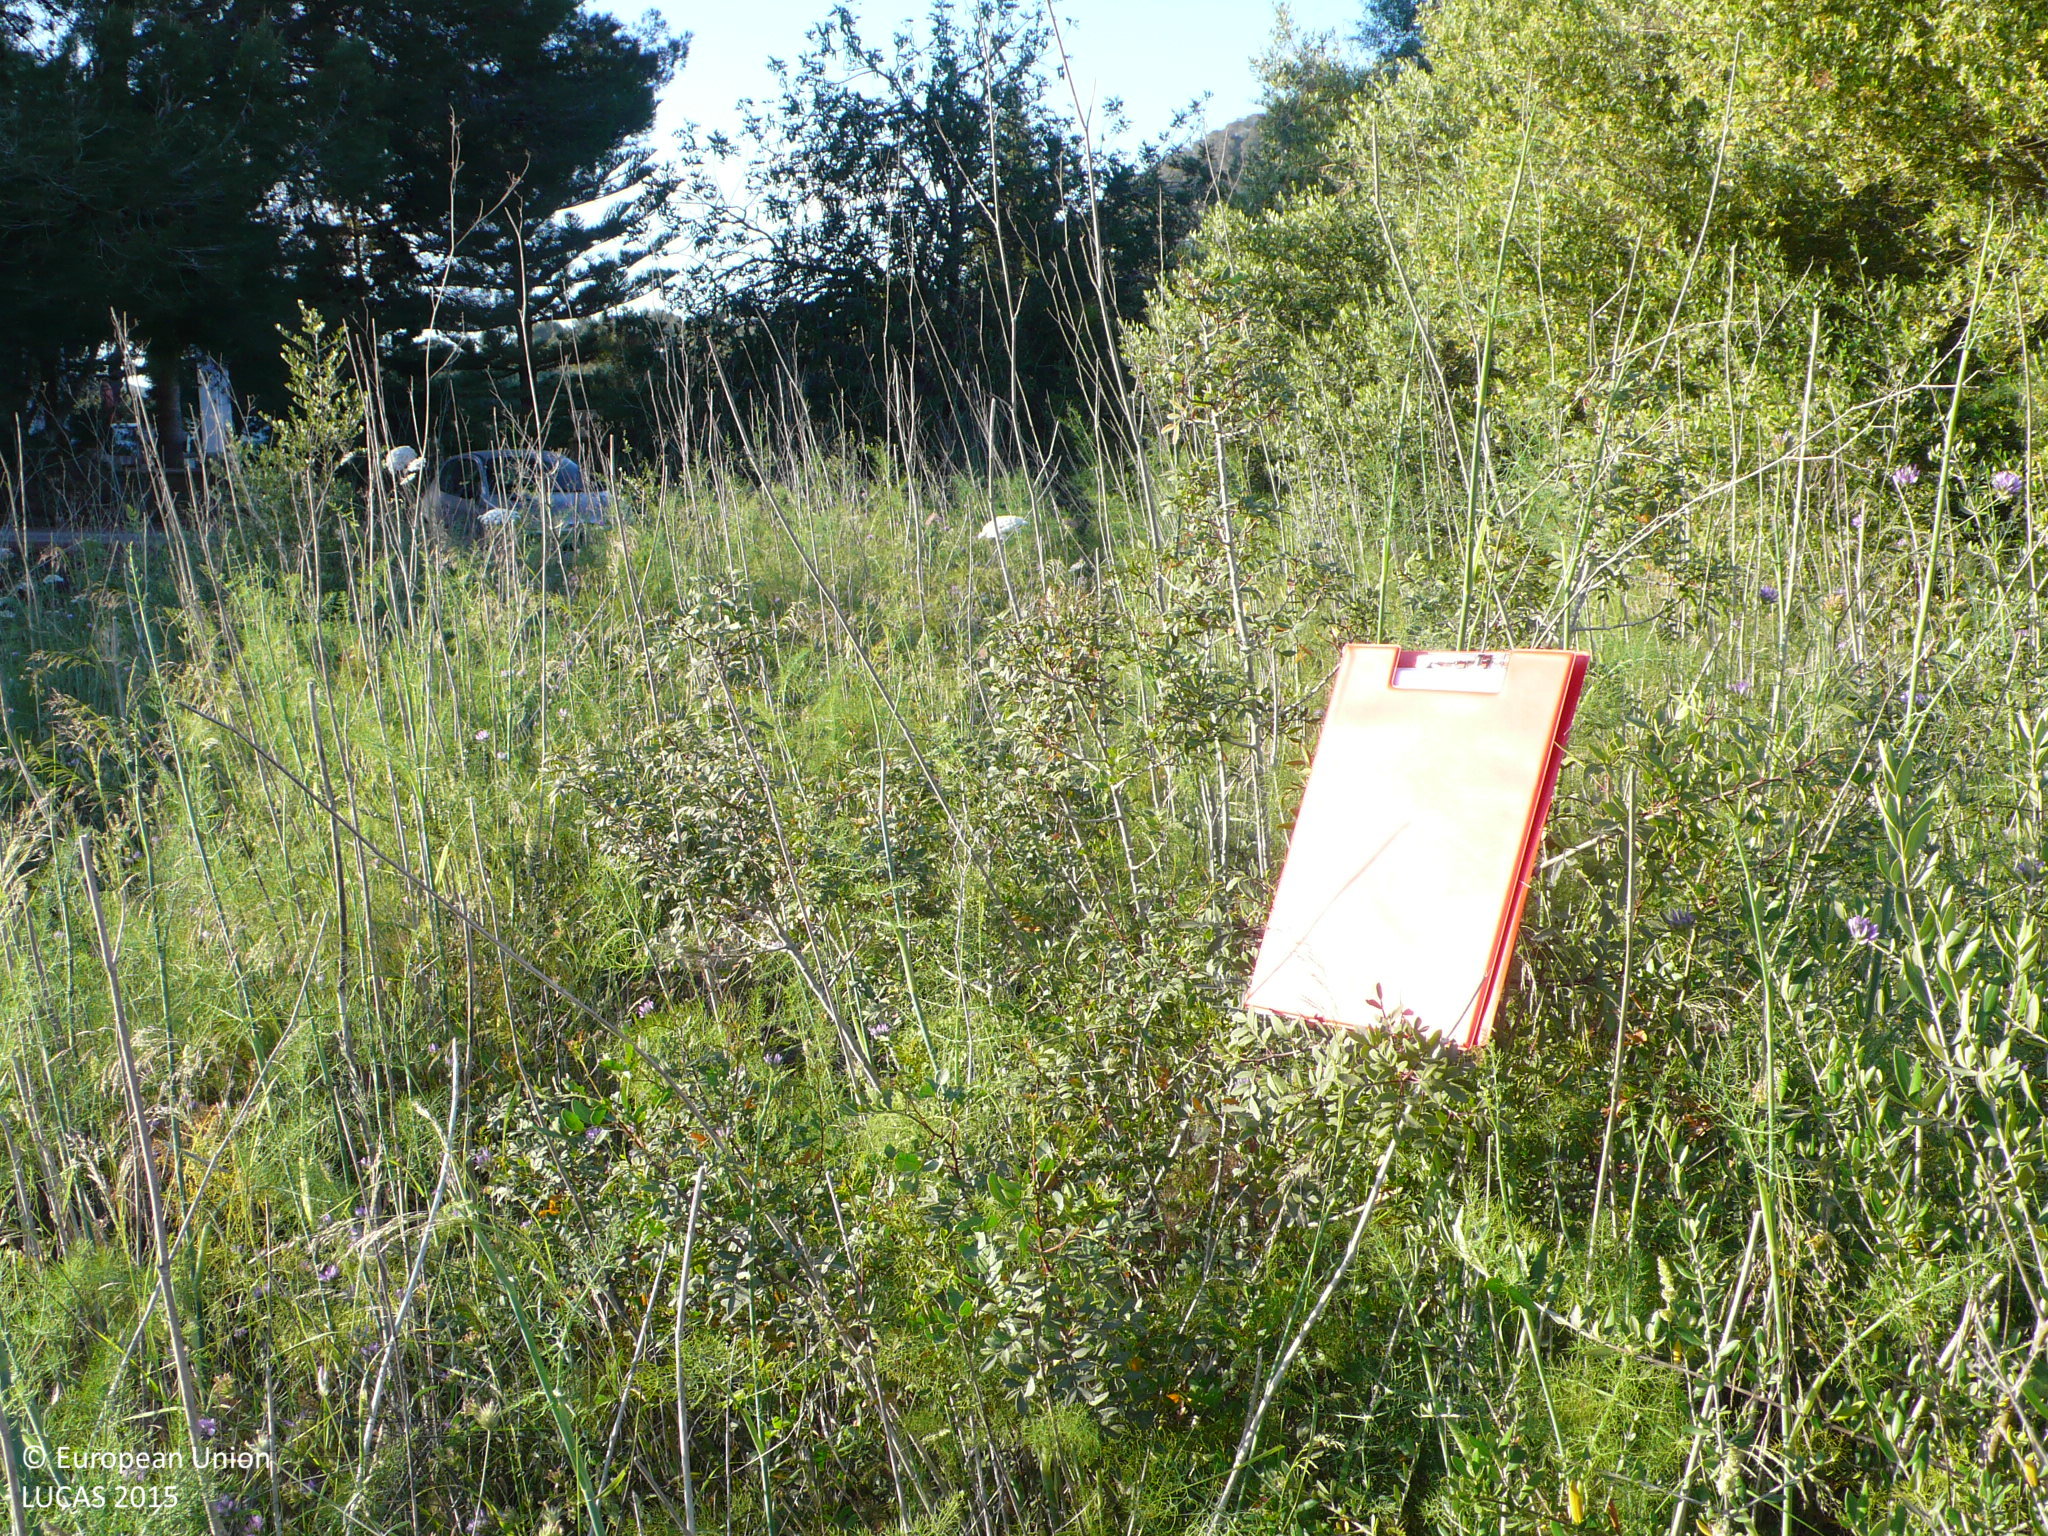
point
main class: Woodland
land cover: Broadleaved woodland
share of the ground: 10 - 25 %
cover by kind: shrubs 65 %, broadleaved forest trees 20 %, consolidated bare surface 15 %
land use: Semi-natural and natural areas not in use
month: May
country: ES
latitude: 38.9523
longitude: 1.5082
